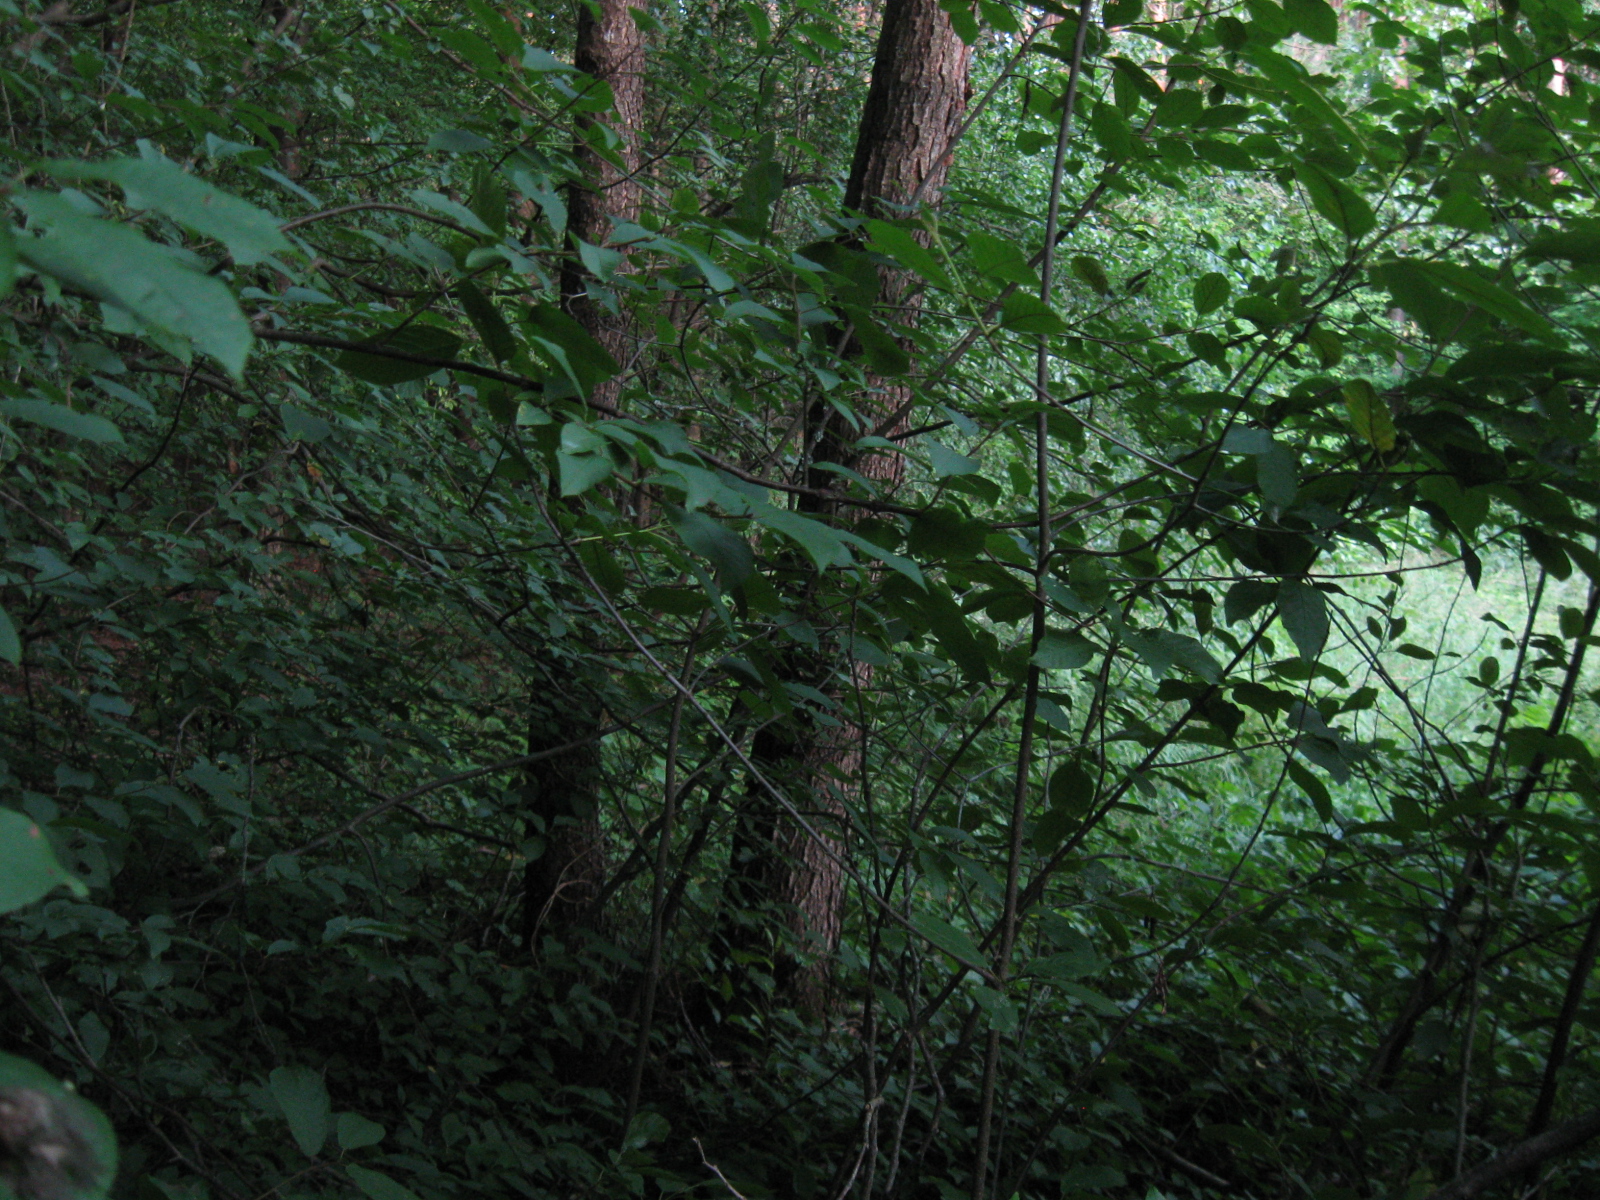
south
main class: Woodland
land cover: Broadleaved woodland
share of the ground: > 75 %
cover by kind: broadleaved forest trees 90 %, shrubs 5 %, herbaceous plants 5 %
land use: Forestry
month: July
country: LT
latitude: 54.3847
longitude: 24.3744
